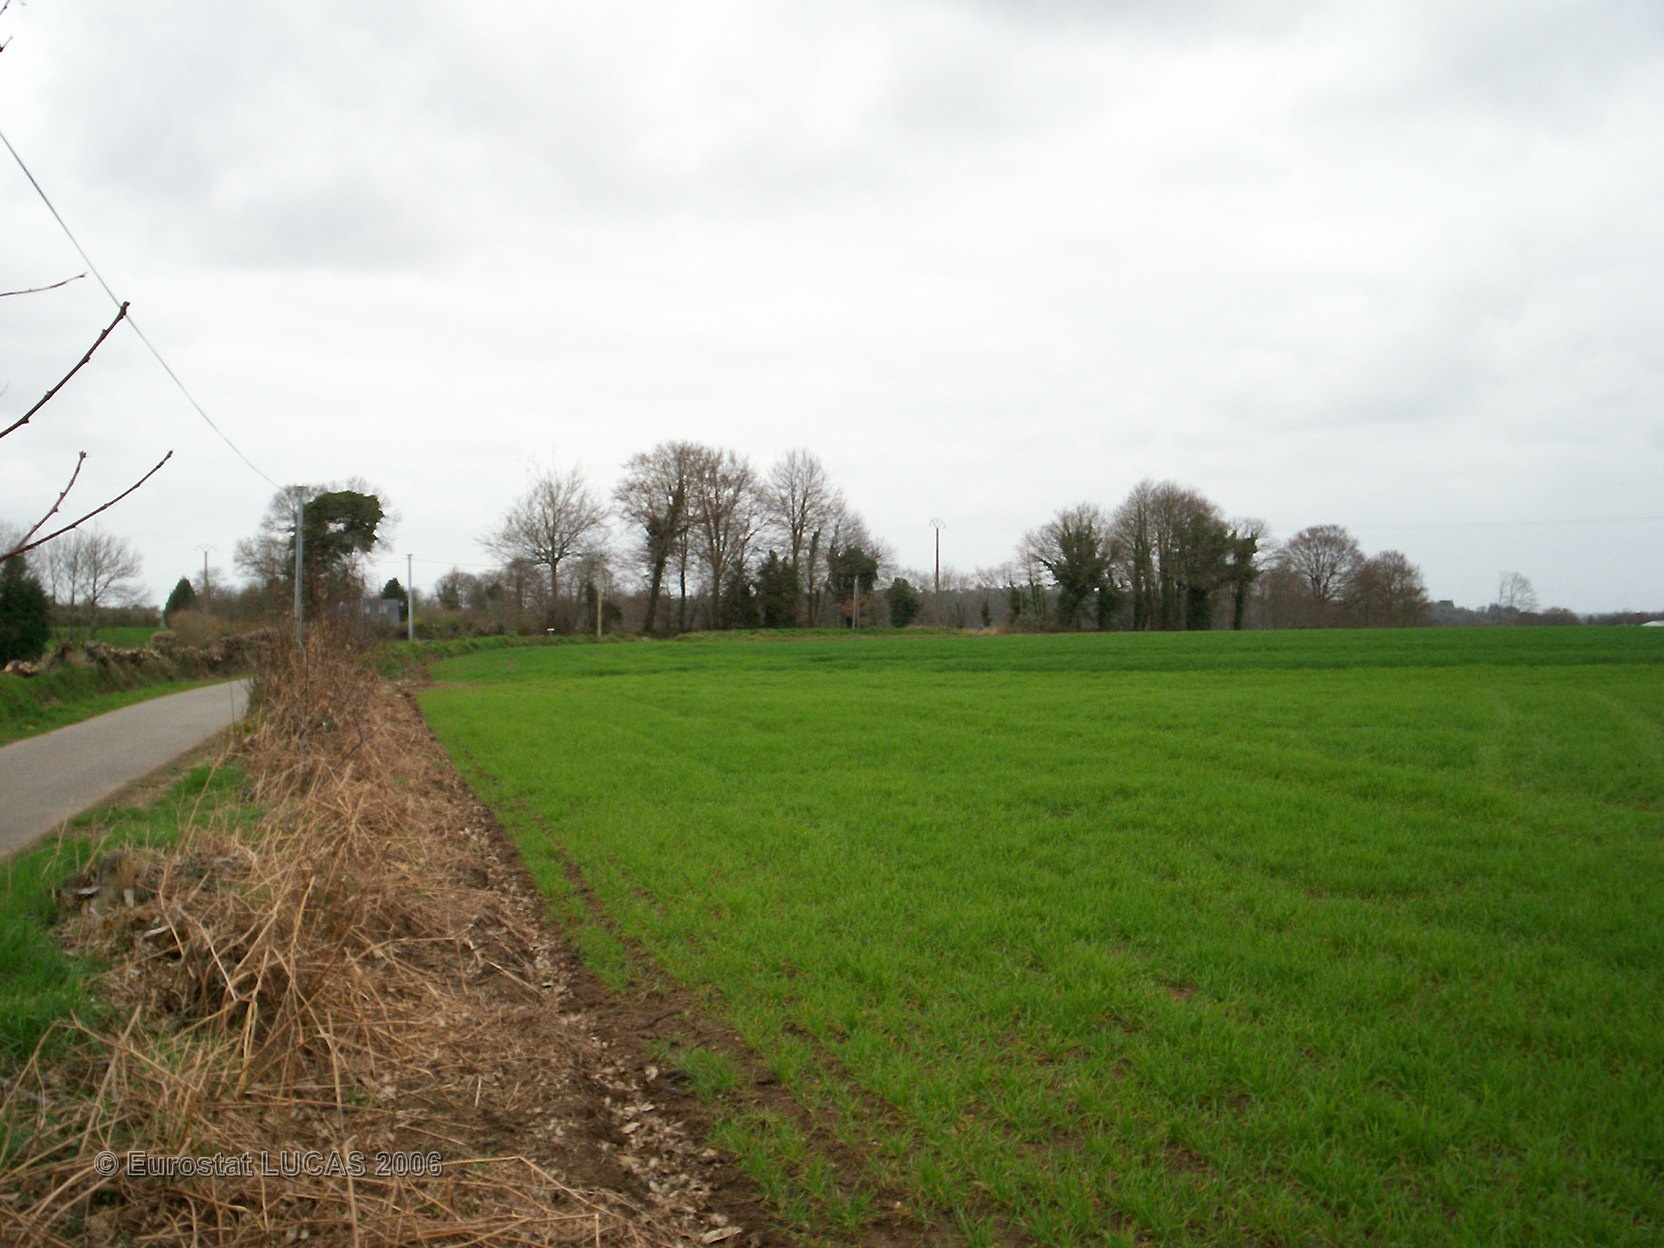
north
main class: Cropland
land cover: Common wheat
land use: Agriculture (excluding fallow land and kitchen gardens)
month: April
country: FR
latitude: 47.9818
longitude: -3.5695
